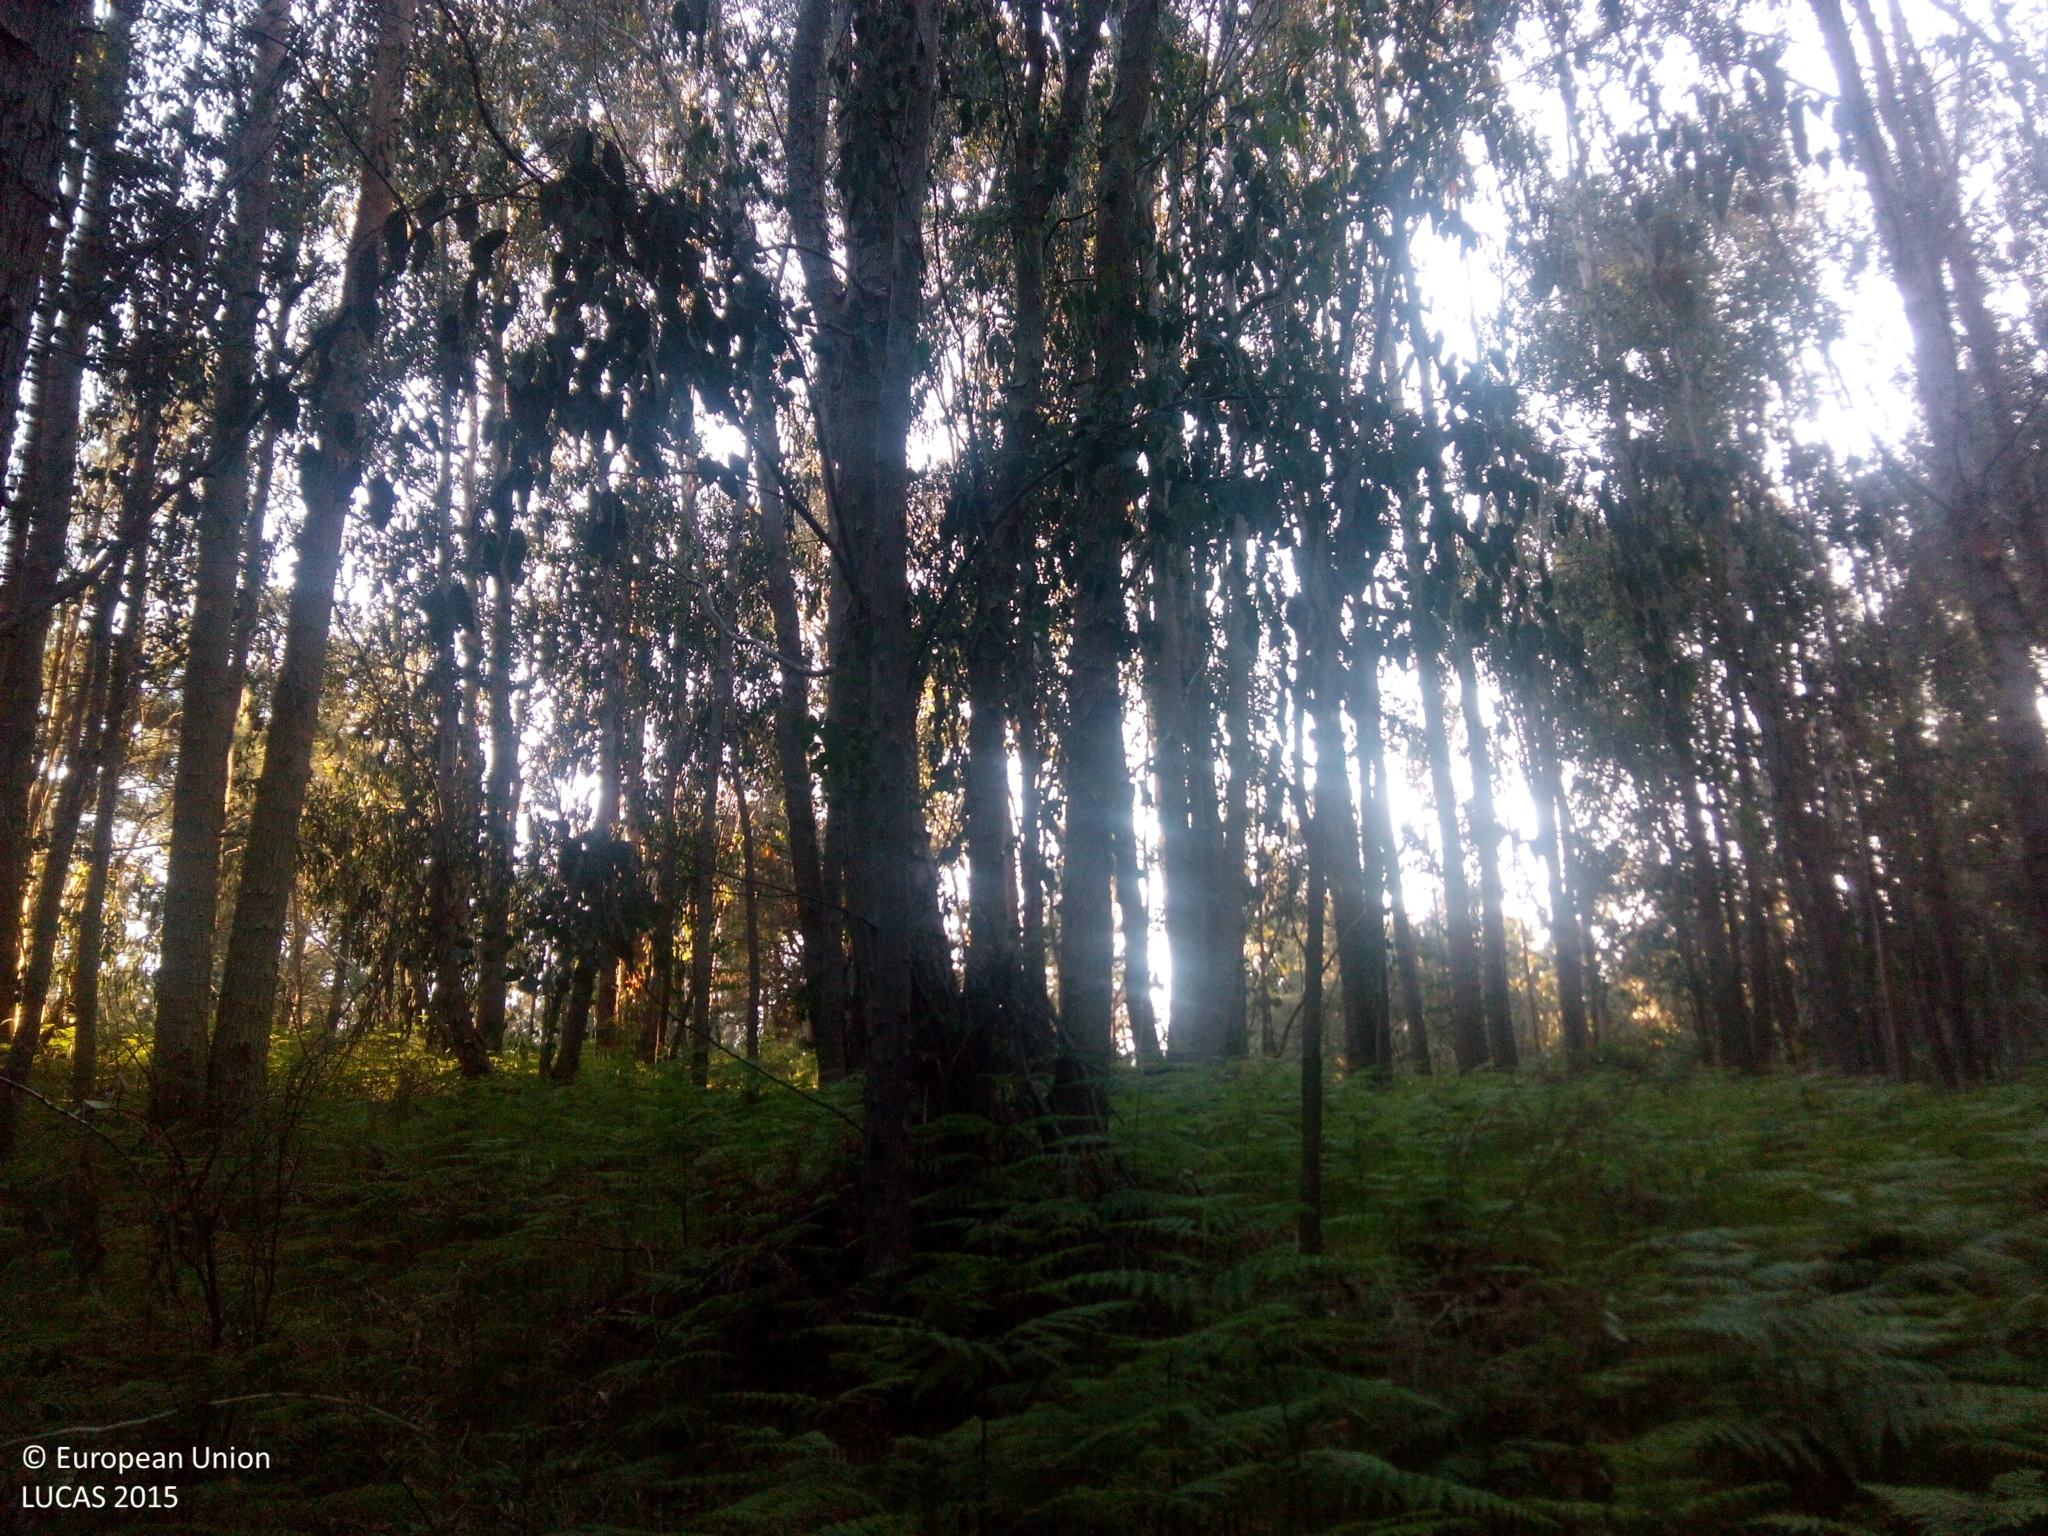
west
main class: Woodland
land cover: Broadleaved woodland
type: exotic forest
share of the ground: > 75 %
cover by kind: broadleaved forest trees 70 %, shrubs 20 %, herbaceous plants 10 %
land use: Forestry
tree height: > 5 m
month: June
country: ES
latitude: 42.2218
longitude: -8.3218
